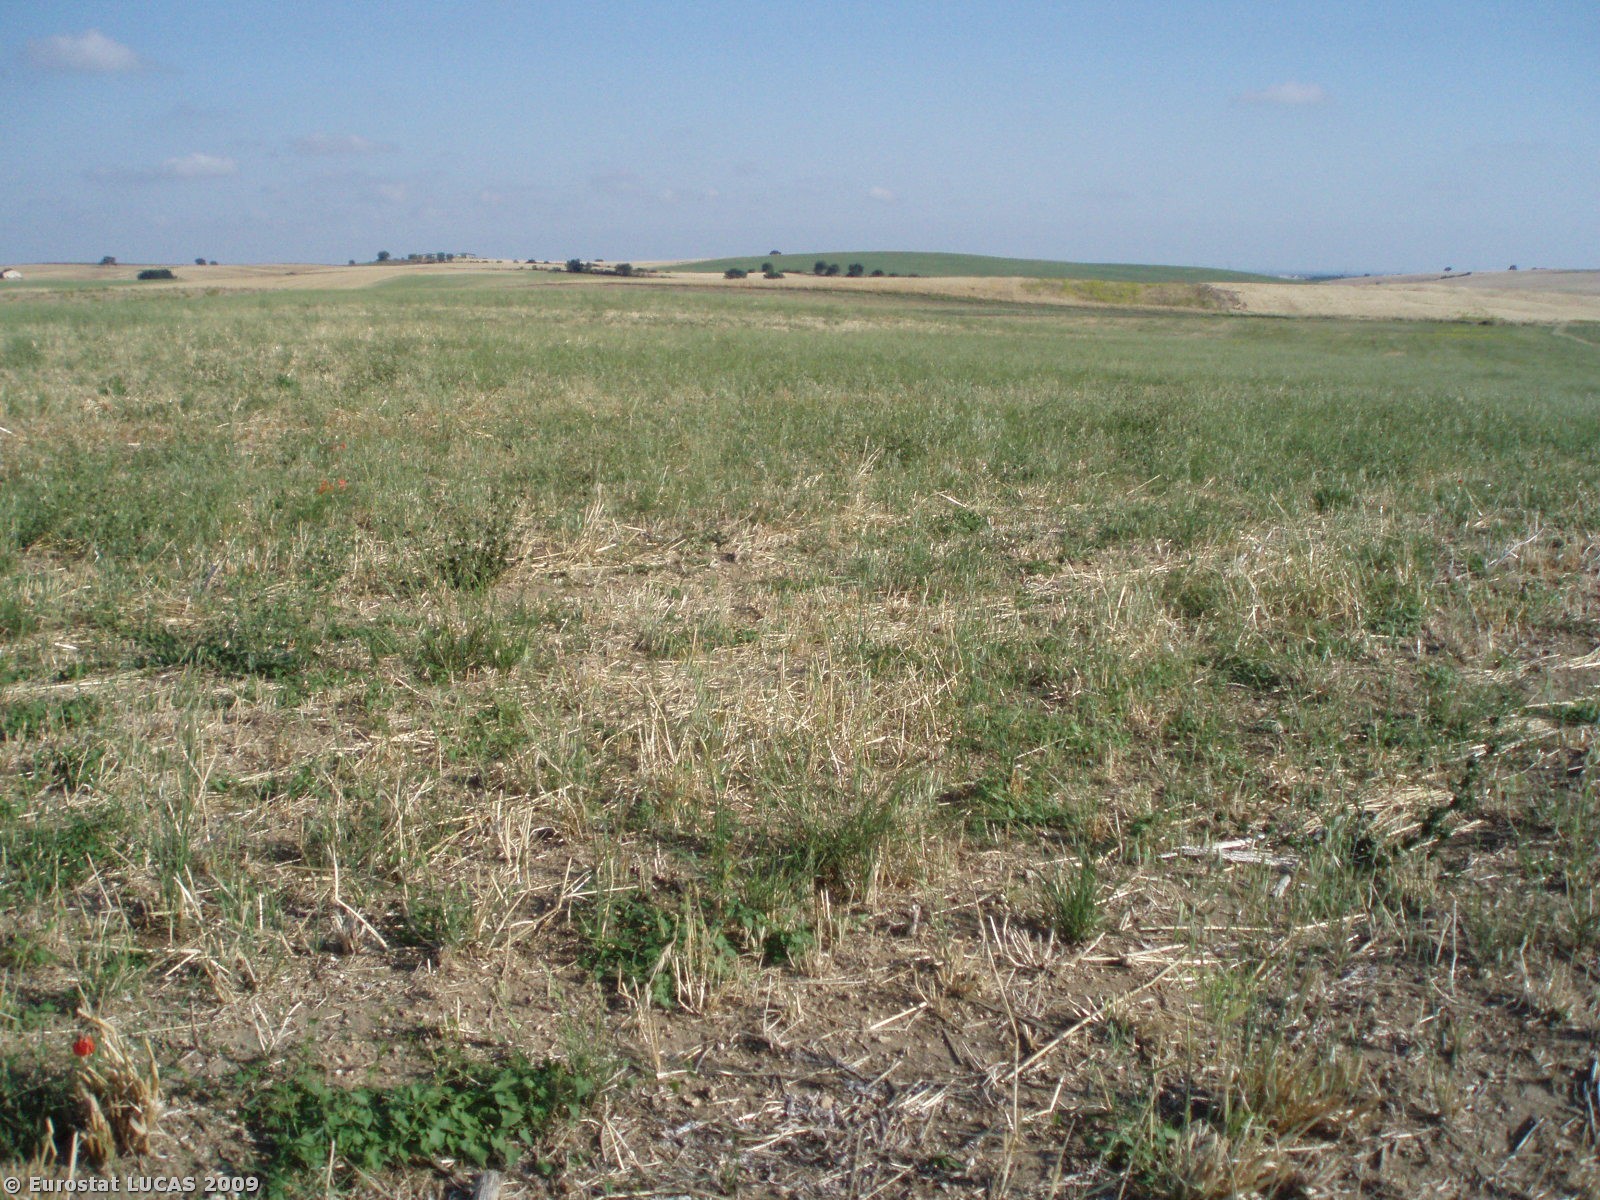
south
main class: Cropland
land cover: Temporary grasslands
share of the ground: > 75 %
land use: Agriculture (excluding fallow land and kitchen gardens)
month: June
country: IT
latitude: 42.4429
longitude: 11.5871
